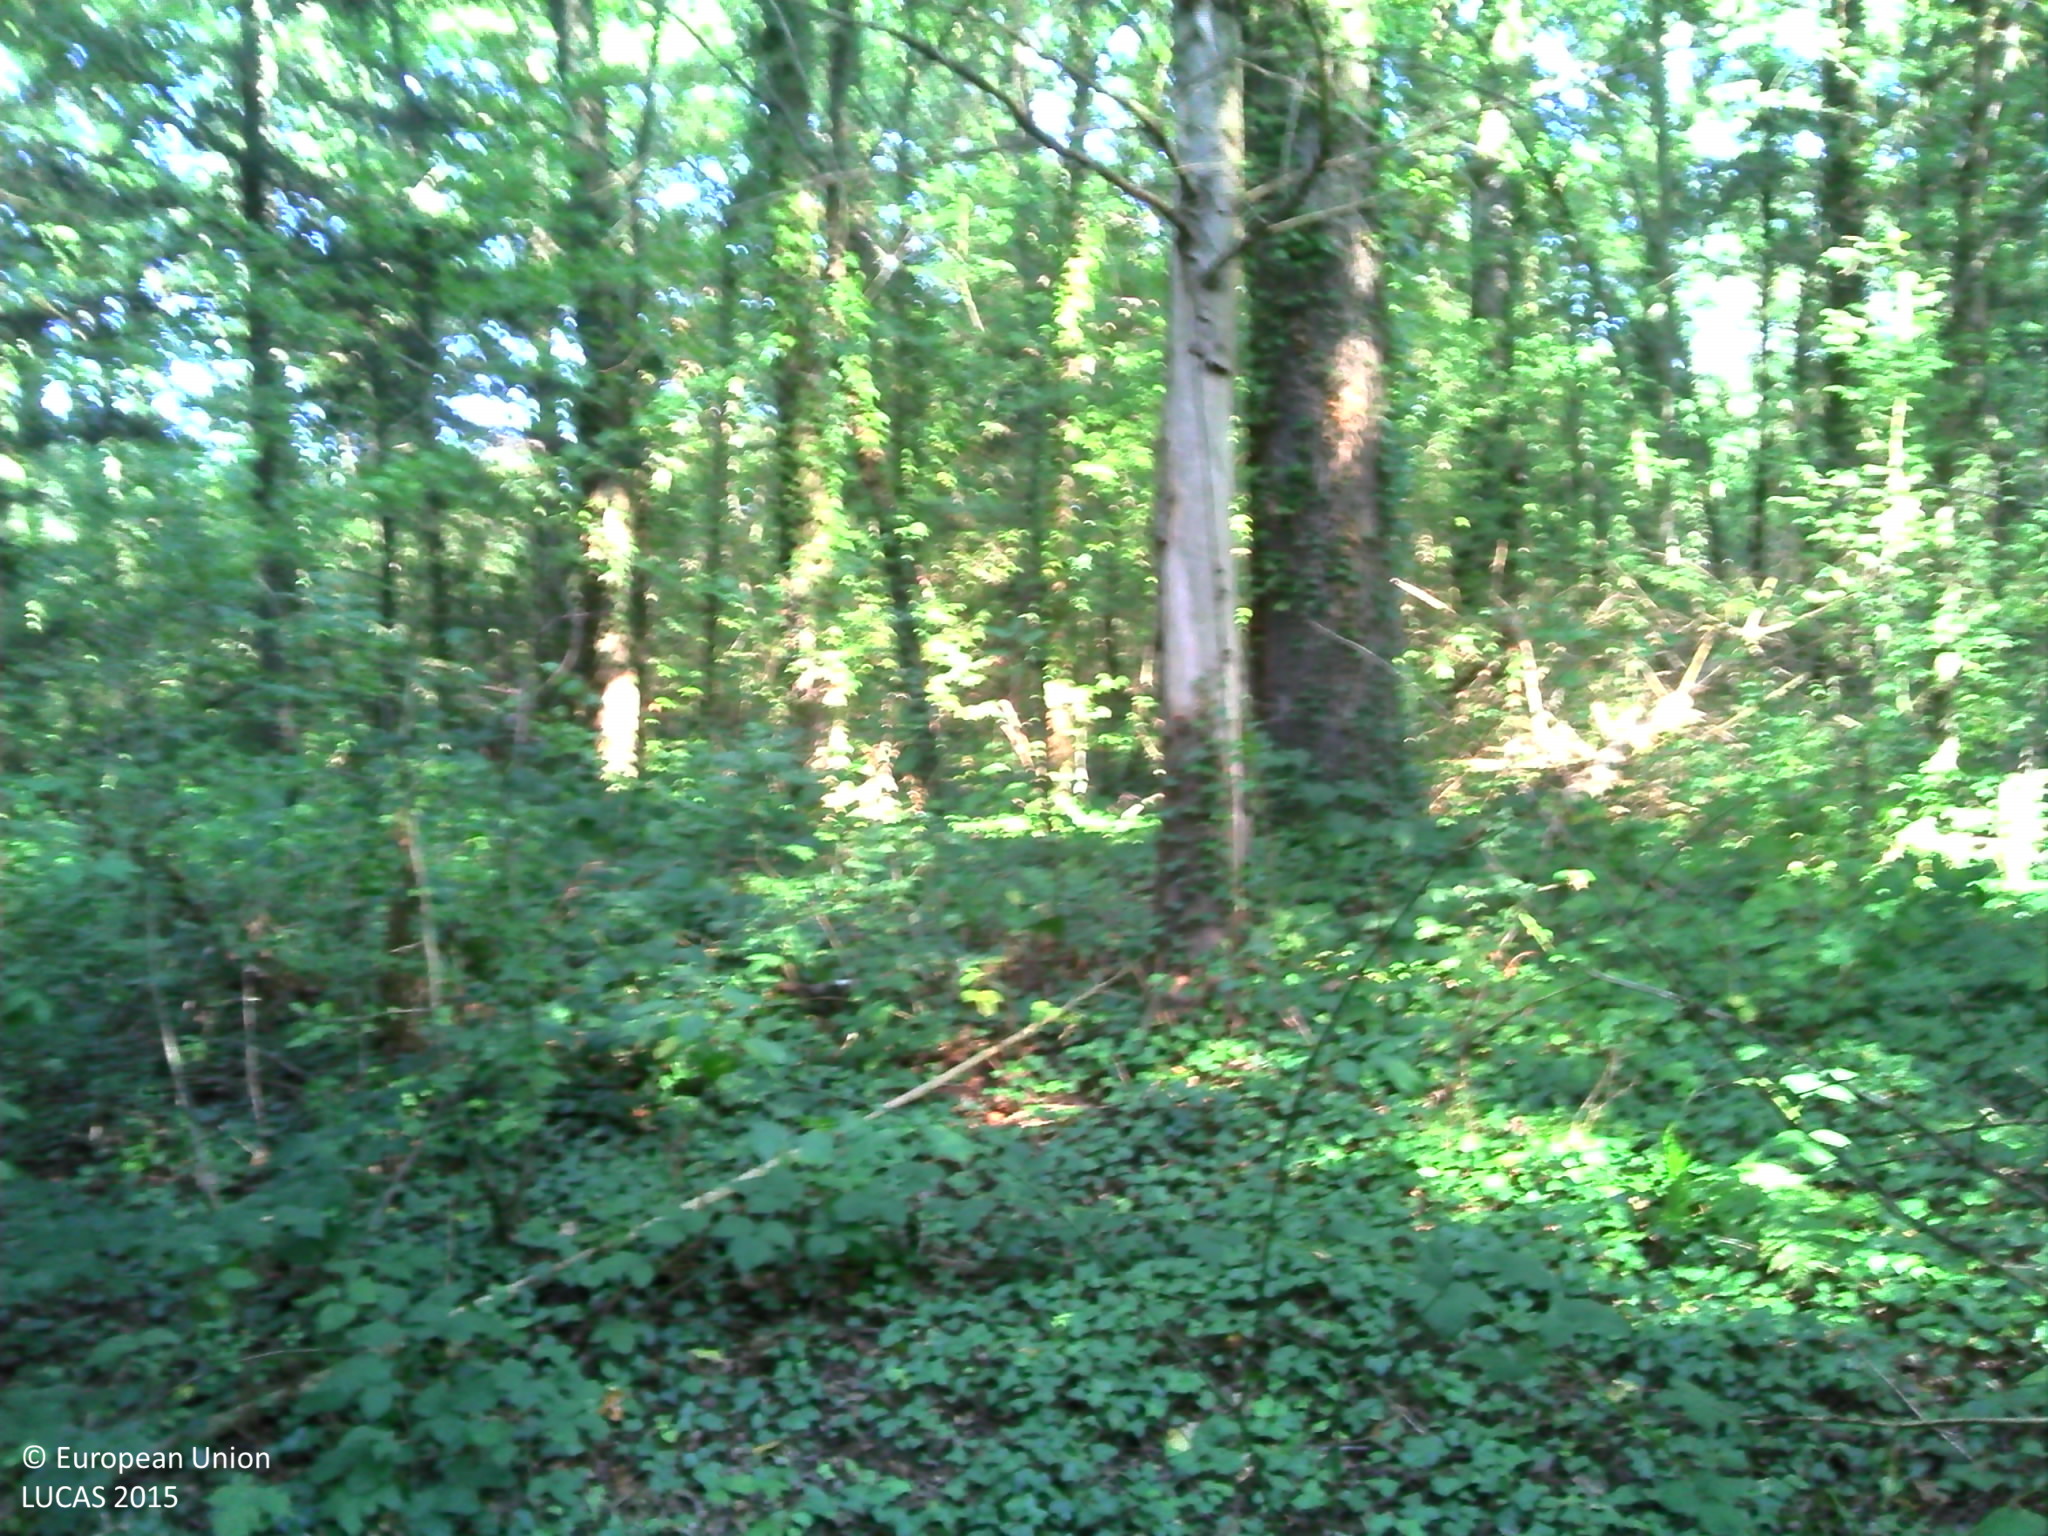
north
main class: Woodland
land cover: Spruce dominated mixed woodland
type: mesophytic deciduous forest
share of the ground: > 75 %
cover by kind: broadleaved forest trees 70 %, coniferous forest trees 30 %
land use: Forestry
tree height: > 5 m
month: October
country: FR
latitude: 48.1819
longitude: 4.2540
